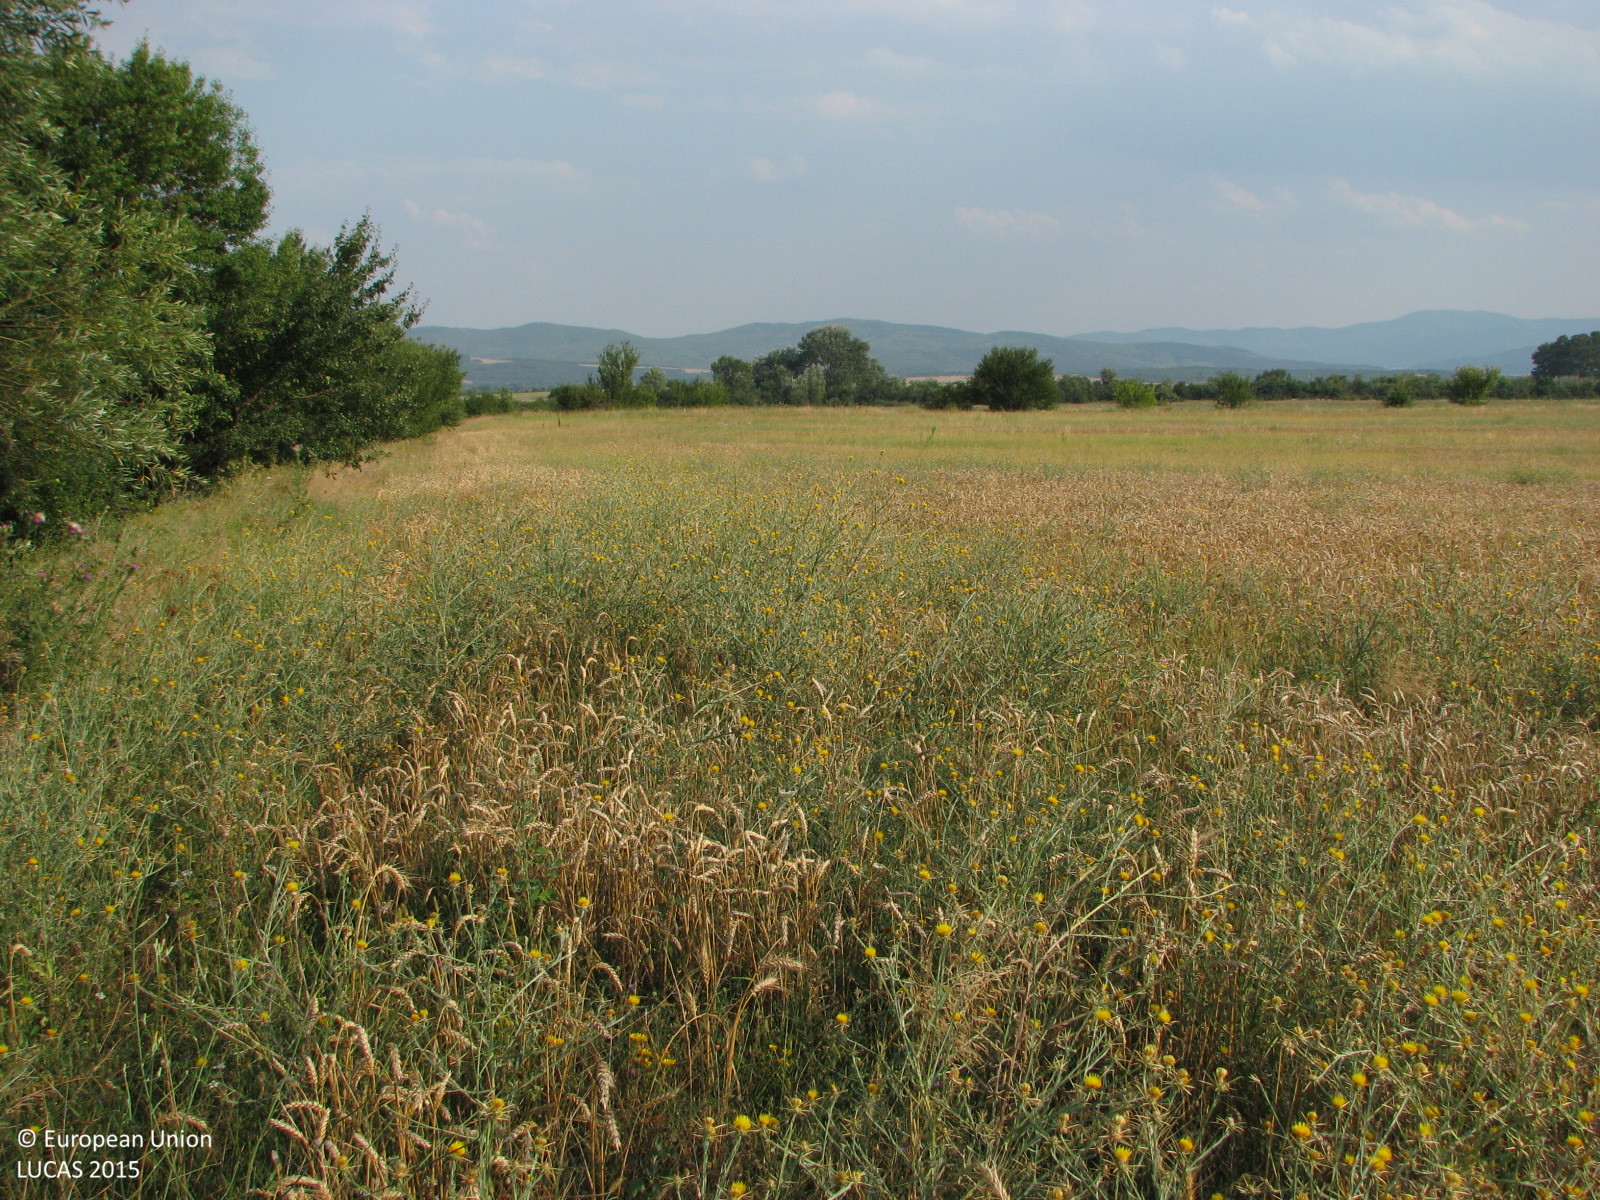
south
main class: Cropland
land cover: Common wheat
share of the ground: > 75 %
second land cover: Spontaneously vegetated surfaces
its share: 10 - 25 %
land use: Agriculture (excluding fallow land and kitchen gardens)
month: July
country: BG
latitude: 42.6809
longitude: 25.8594
